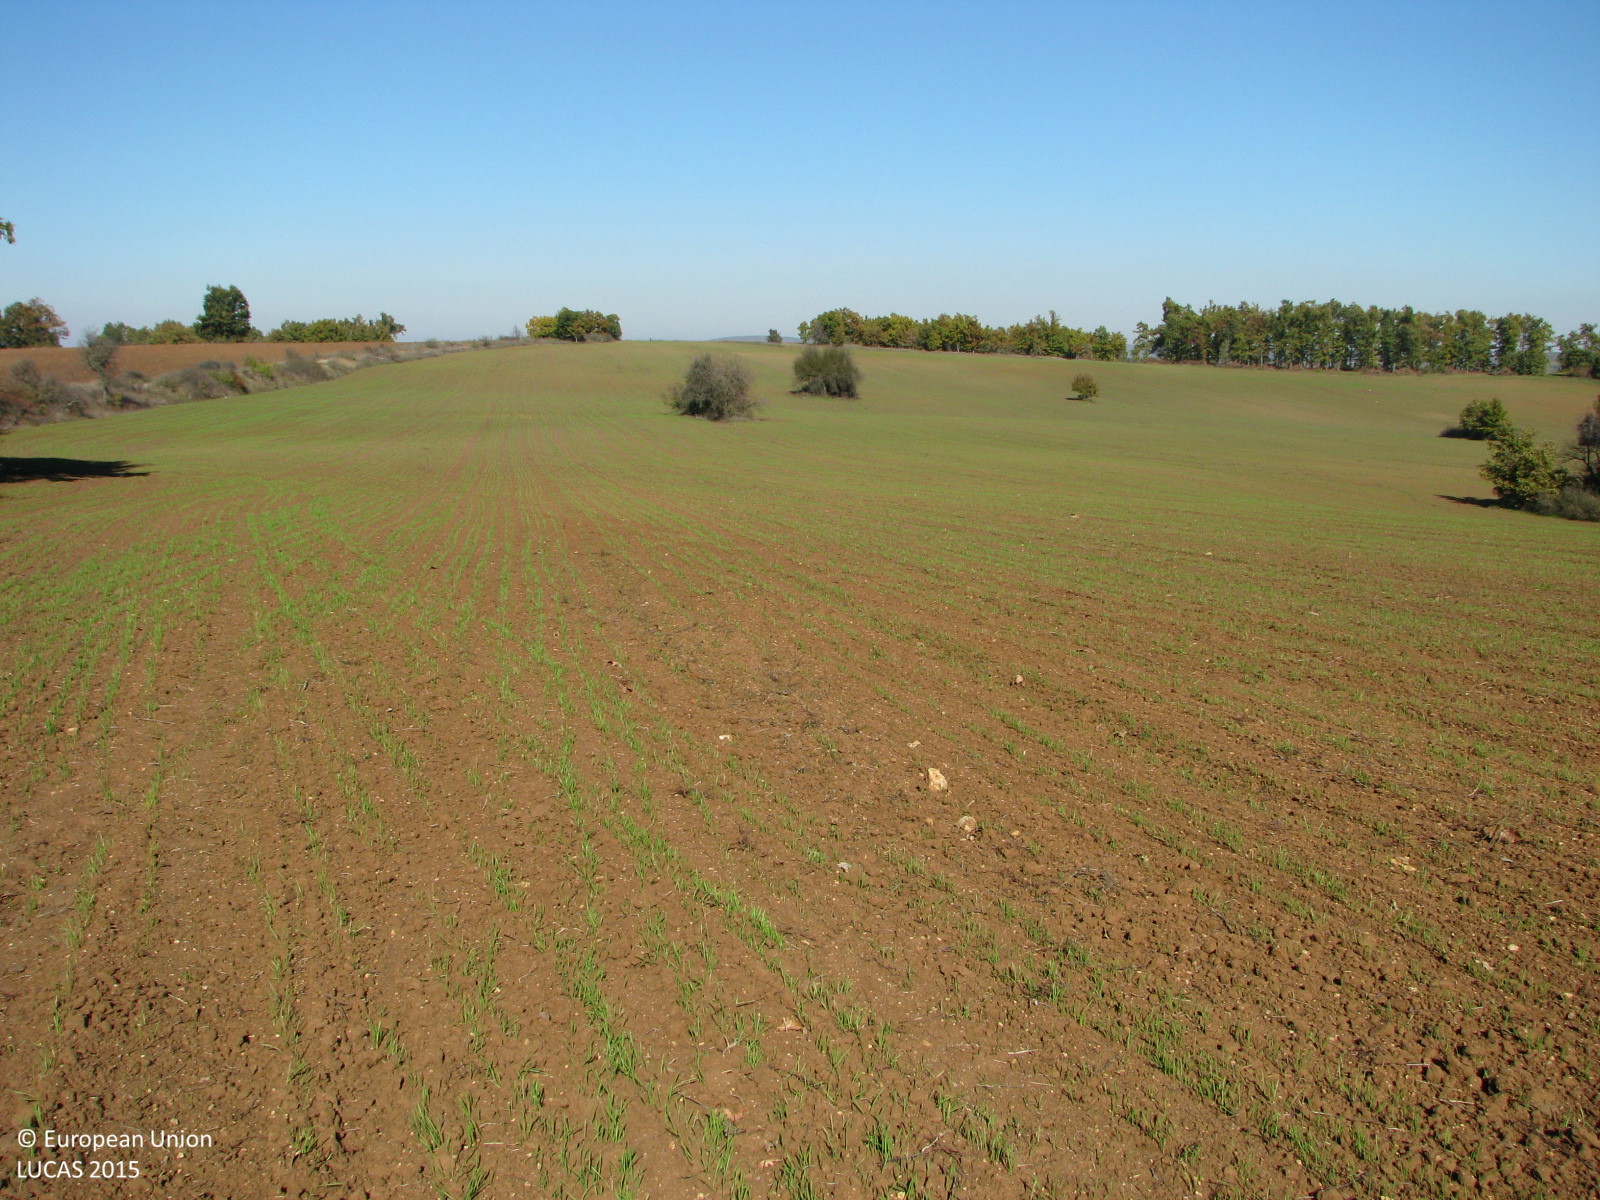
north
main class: Cropland
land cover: Common wheat
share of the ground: 10 - 25 %
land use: Agriculture (excluding fallow land and kitchen gardens)
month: November
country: BG
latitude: 42.0363
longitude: 26.8738
